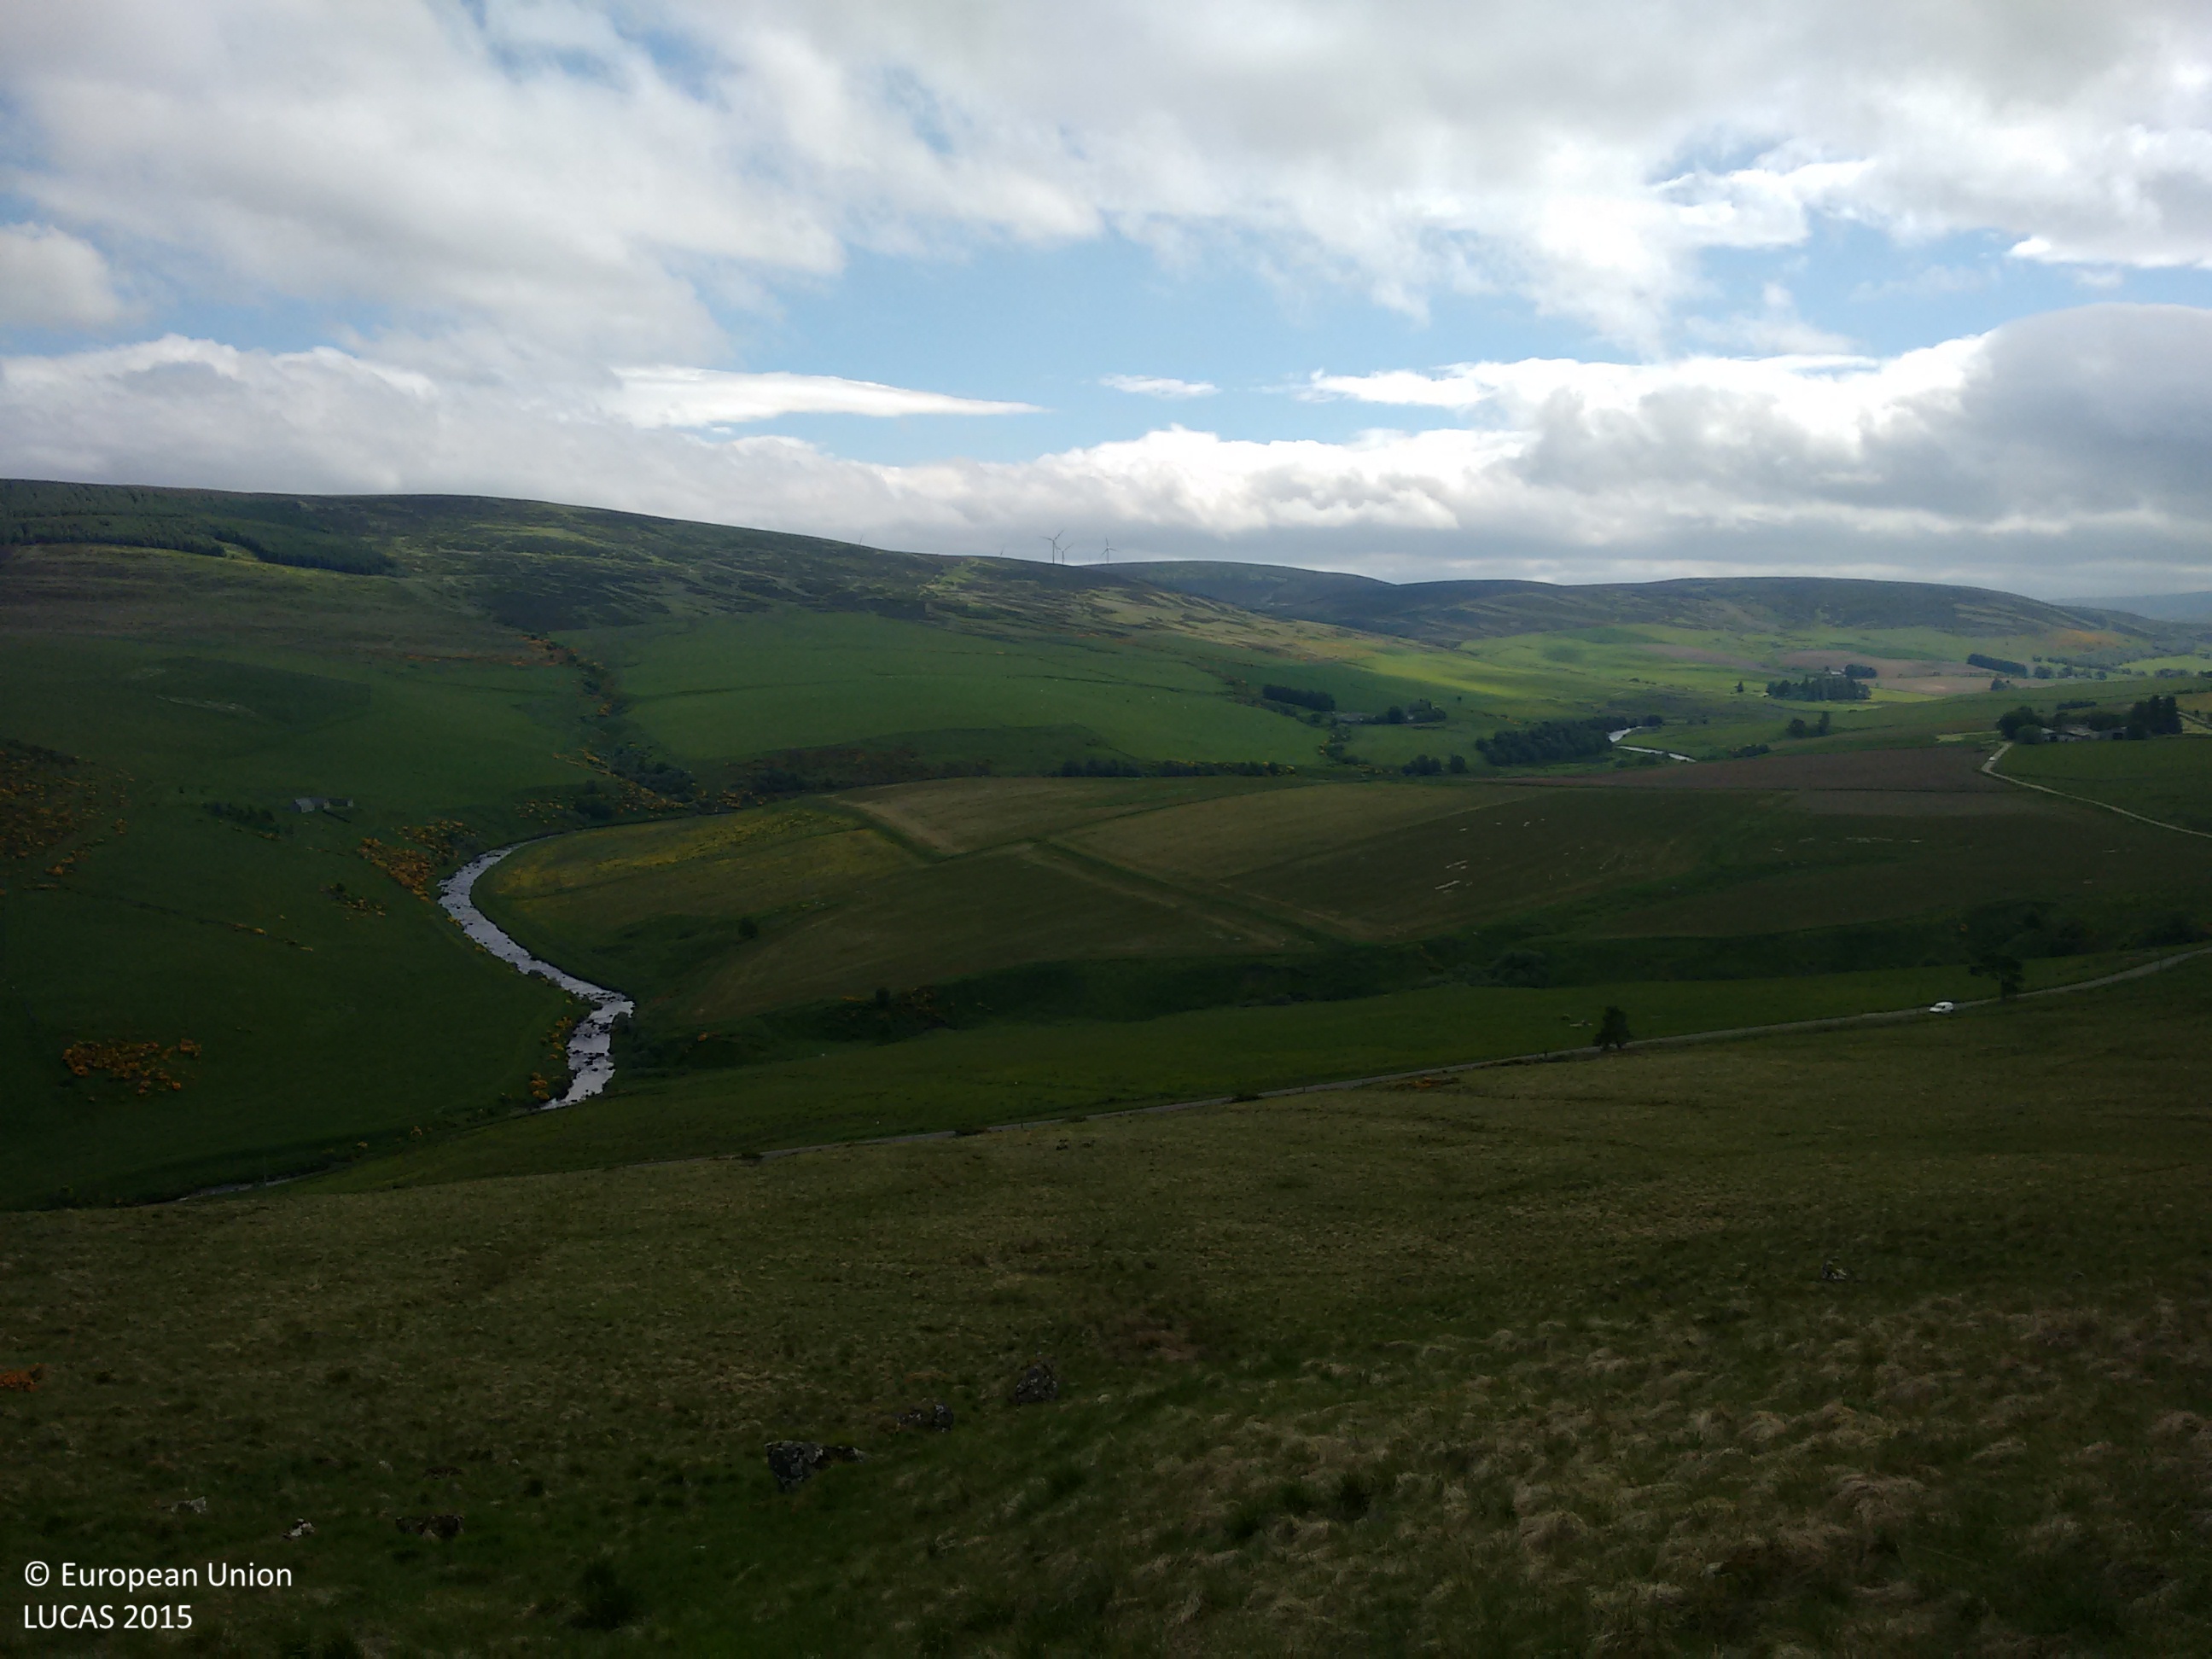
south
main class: Grassland
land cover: Grassland without tree/shrub cover
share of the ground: > 75 %
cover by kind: herbaceous plants 100 %
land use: Agriculture (excluding fallow land and kitchen gardens)
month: June
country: GB
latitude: 57.4027
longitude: -2.9931
